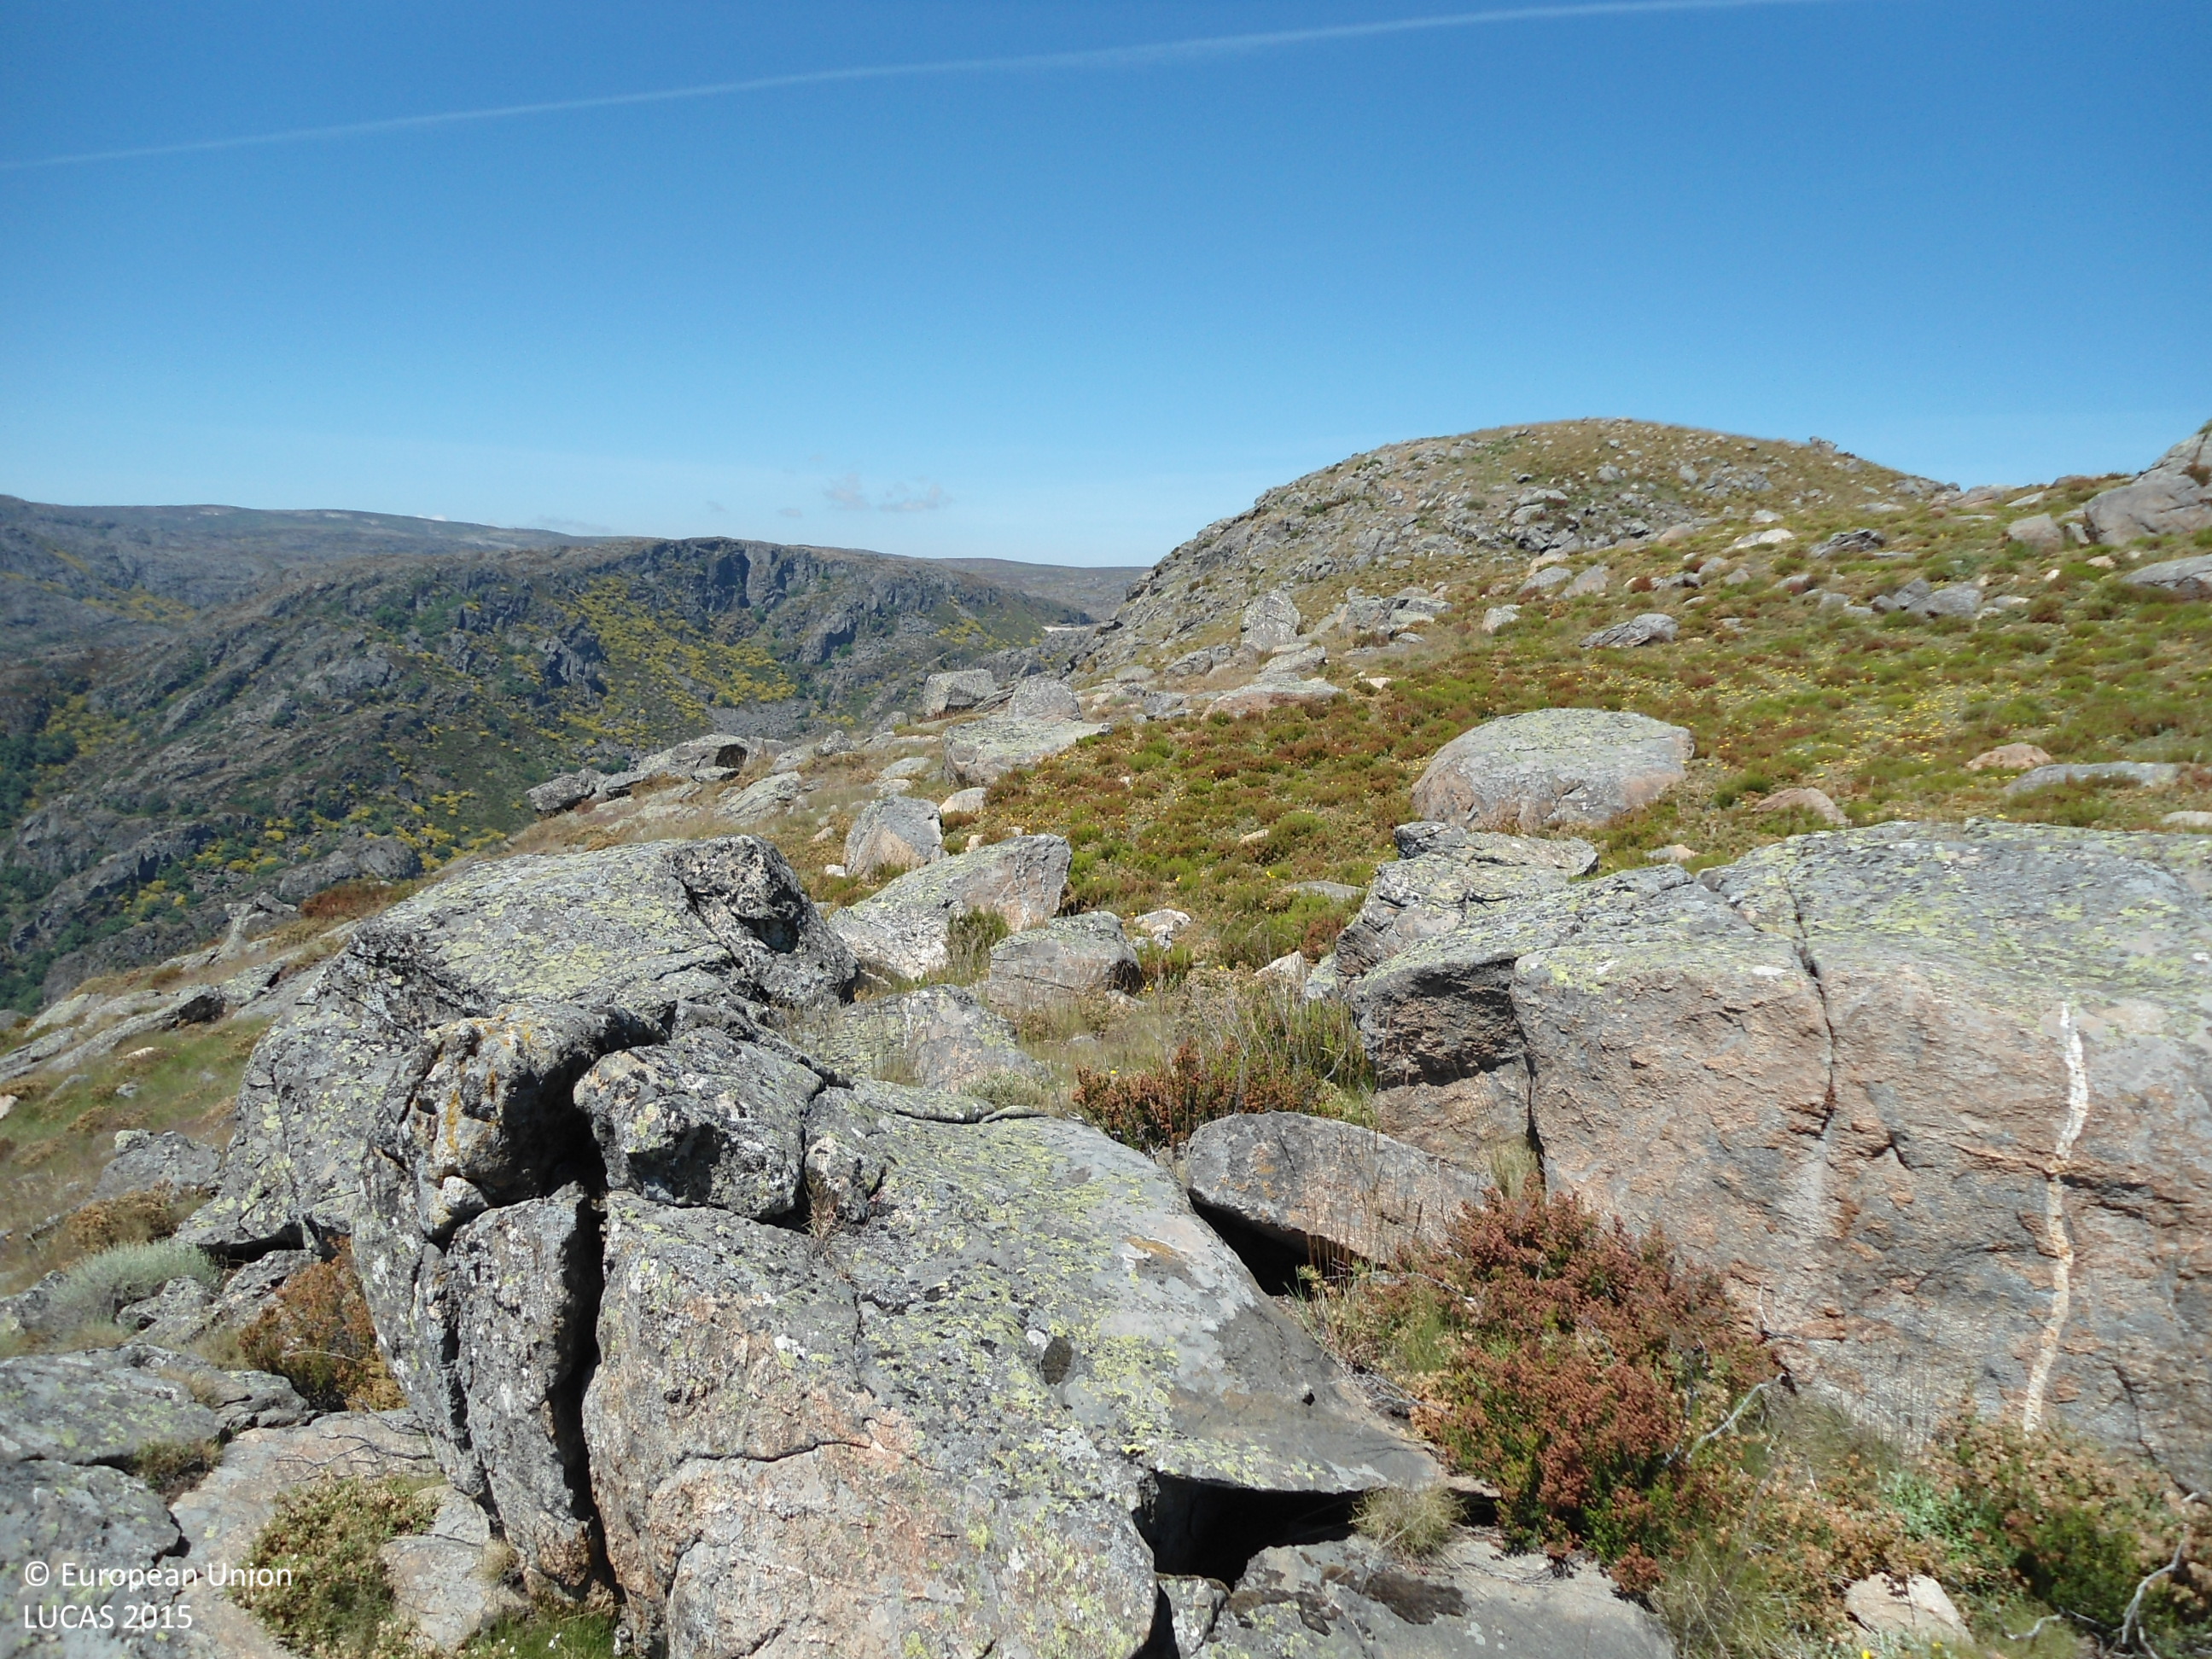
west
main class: Shrubland
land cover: Shrubland with sparse tree cover
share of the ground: 50 - 75 %
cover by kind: shrubs 80 %, consolidated bare surface 15 %, broadleaved forest trees 5 %
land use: Community services
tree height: < 5 m
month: June
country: ES
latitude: 42.1266
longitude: -6.7755
